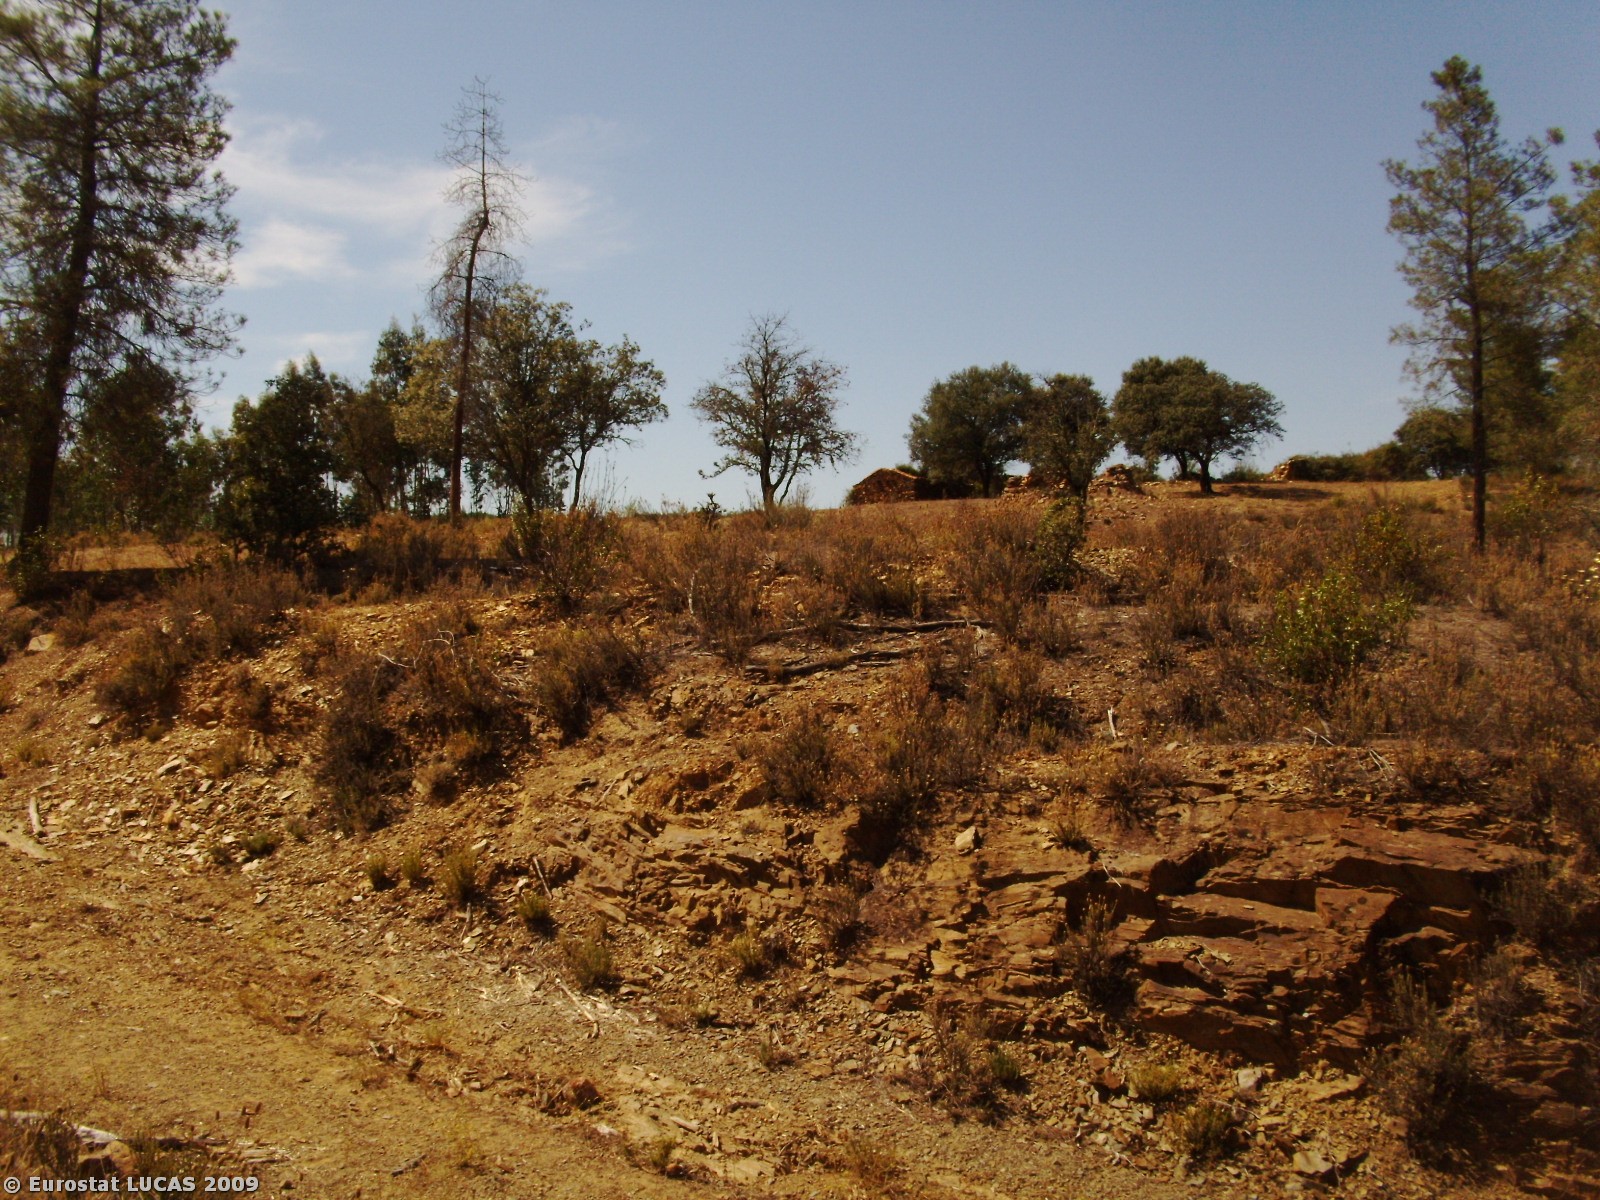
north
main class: Shrubland
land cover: Shrubland with sparse tree cover
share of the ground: 50 - 75 %
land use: Unused
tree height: > 5 m
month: July
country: PT
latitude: 40.0278
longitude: -6.8802
